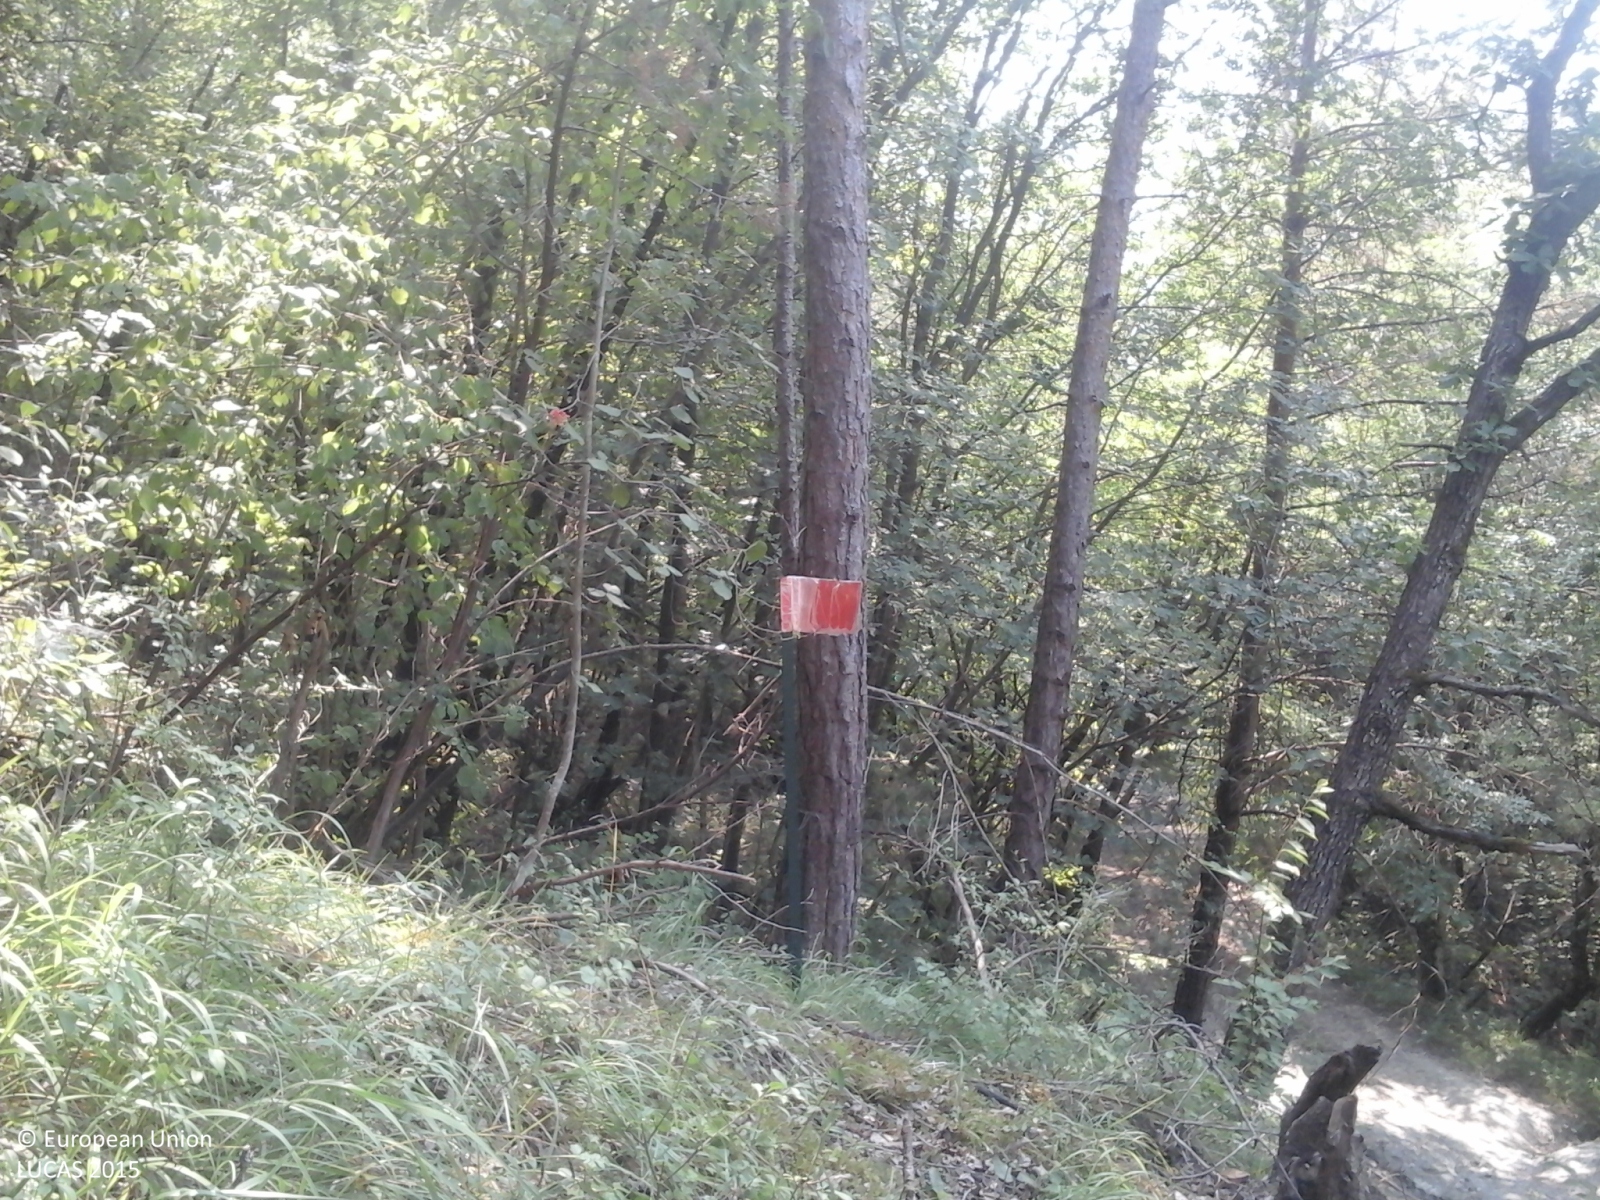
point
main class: Woodland
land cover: Broadleaved woodland
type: thermophilous deciduous forest
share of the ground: > 75 %
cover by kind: broadleaved forest trees 90 %, coniferous forest trees 10 %
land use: Forestry
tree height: > 5 m
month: July
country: IT
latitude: 44.4582
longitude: 10.3386
